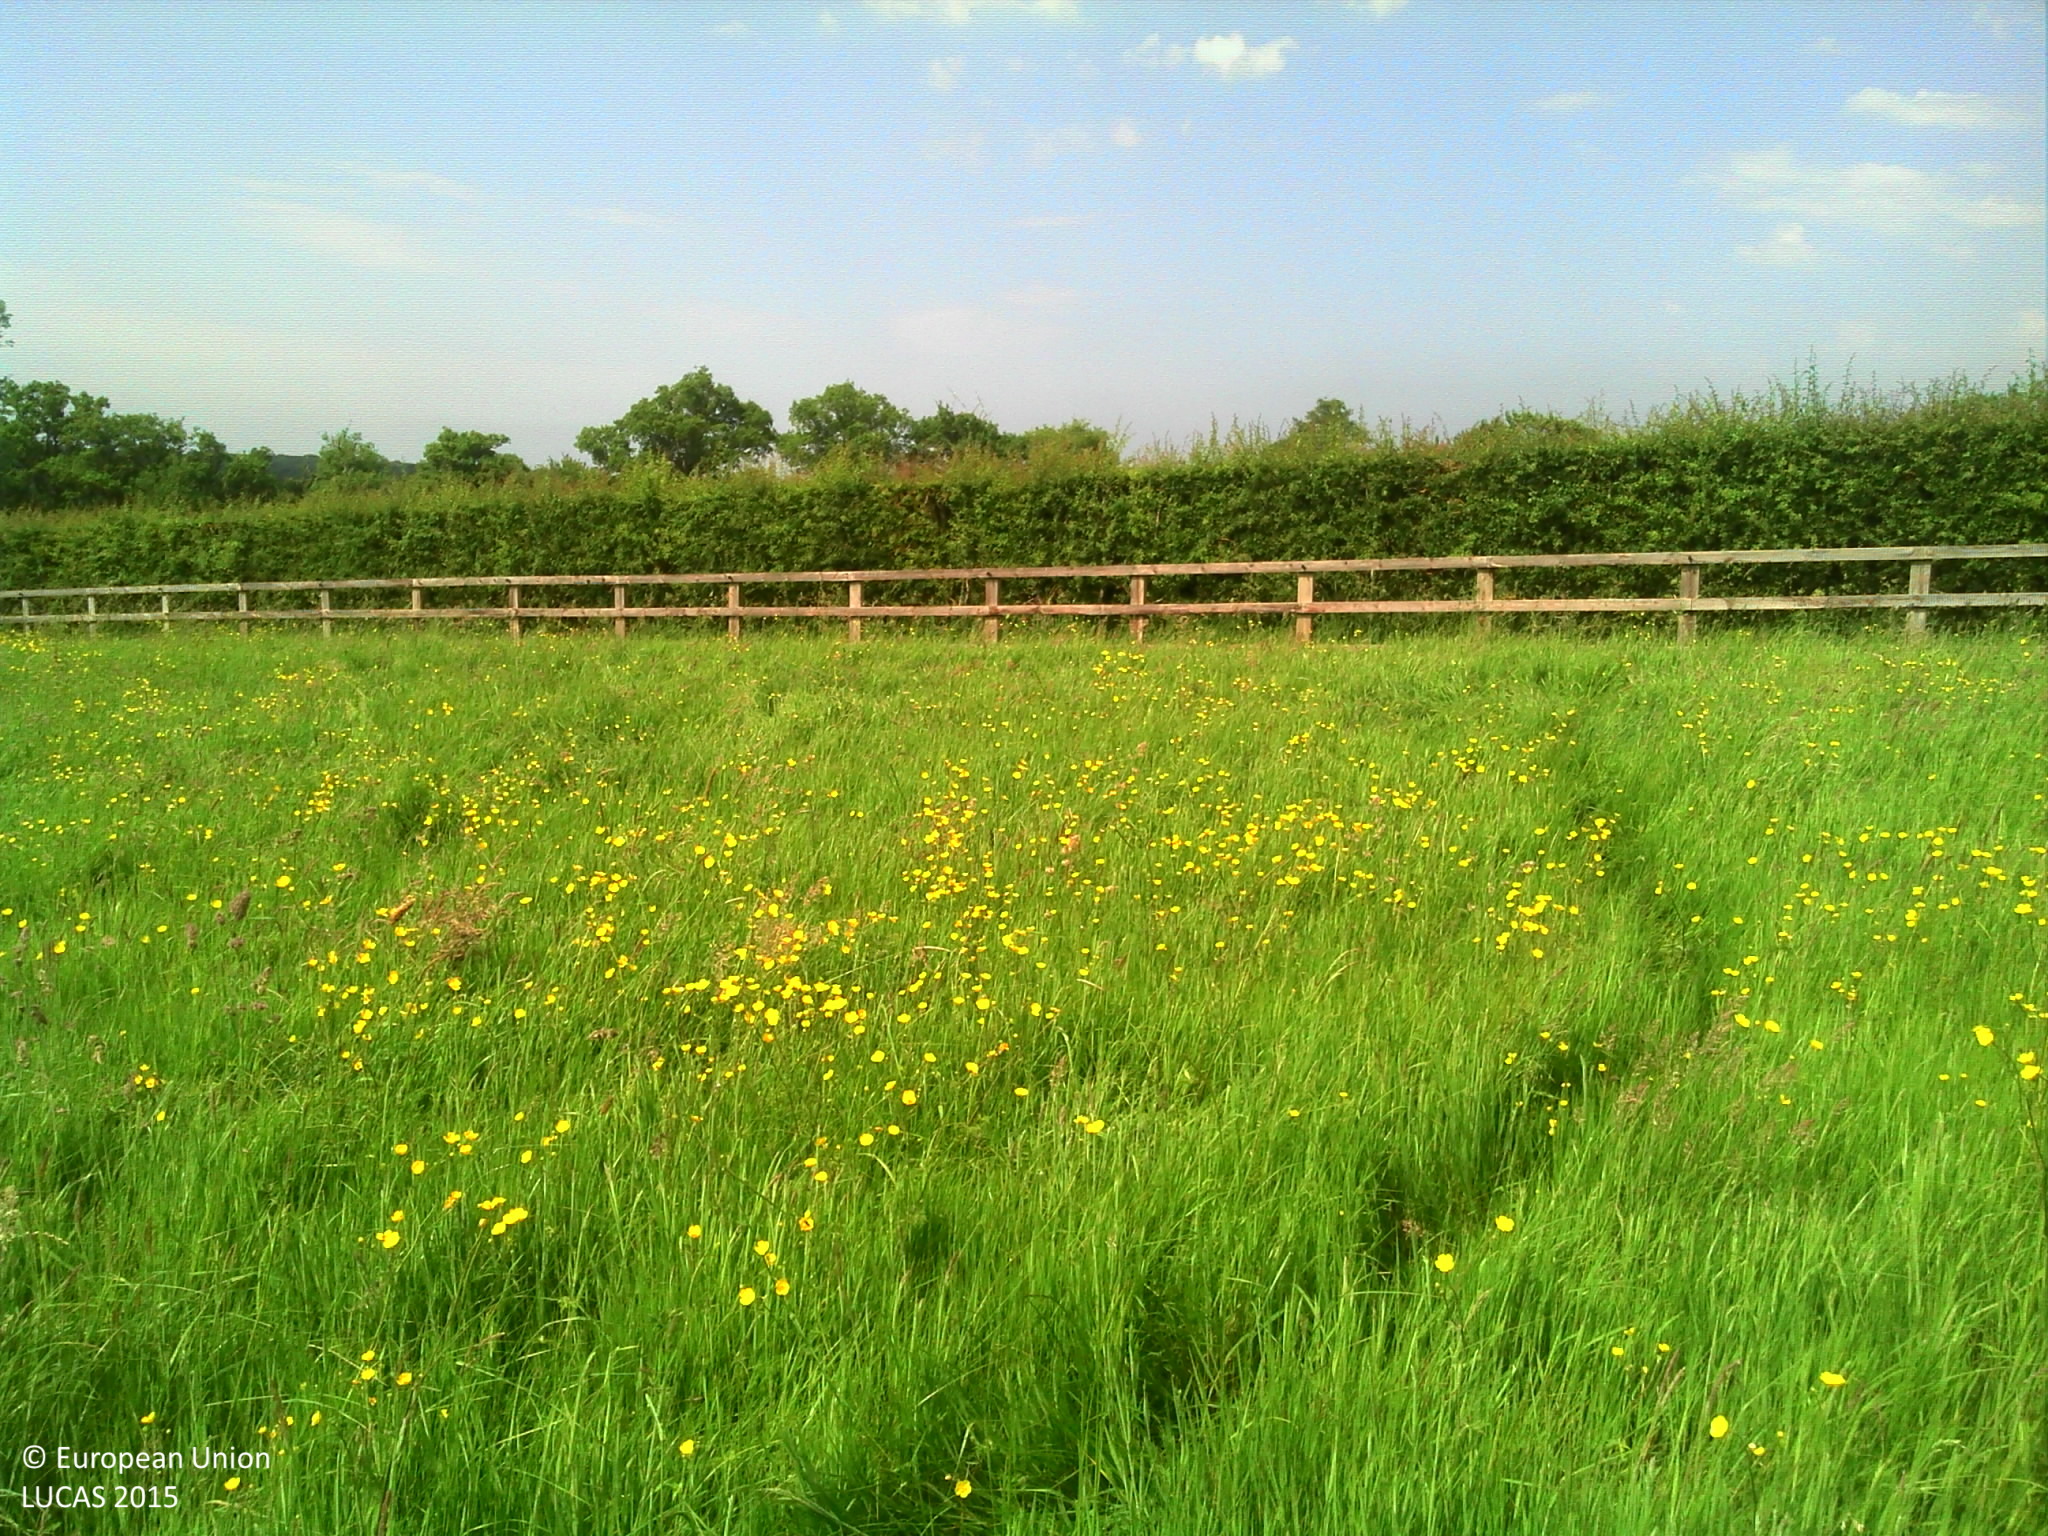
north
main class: Grassland
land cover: Grassland without tree/shrub cover
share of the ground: > 75 %
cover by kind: herbaceous plants 95 %
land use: Agriculture (excluding fallow land and kitchen gardens)
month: June
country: FR
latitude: 48.7257
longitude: 0.1701
